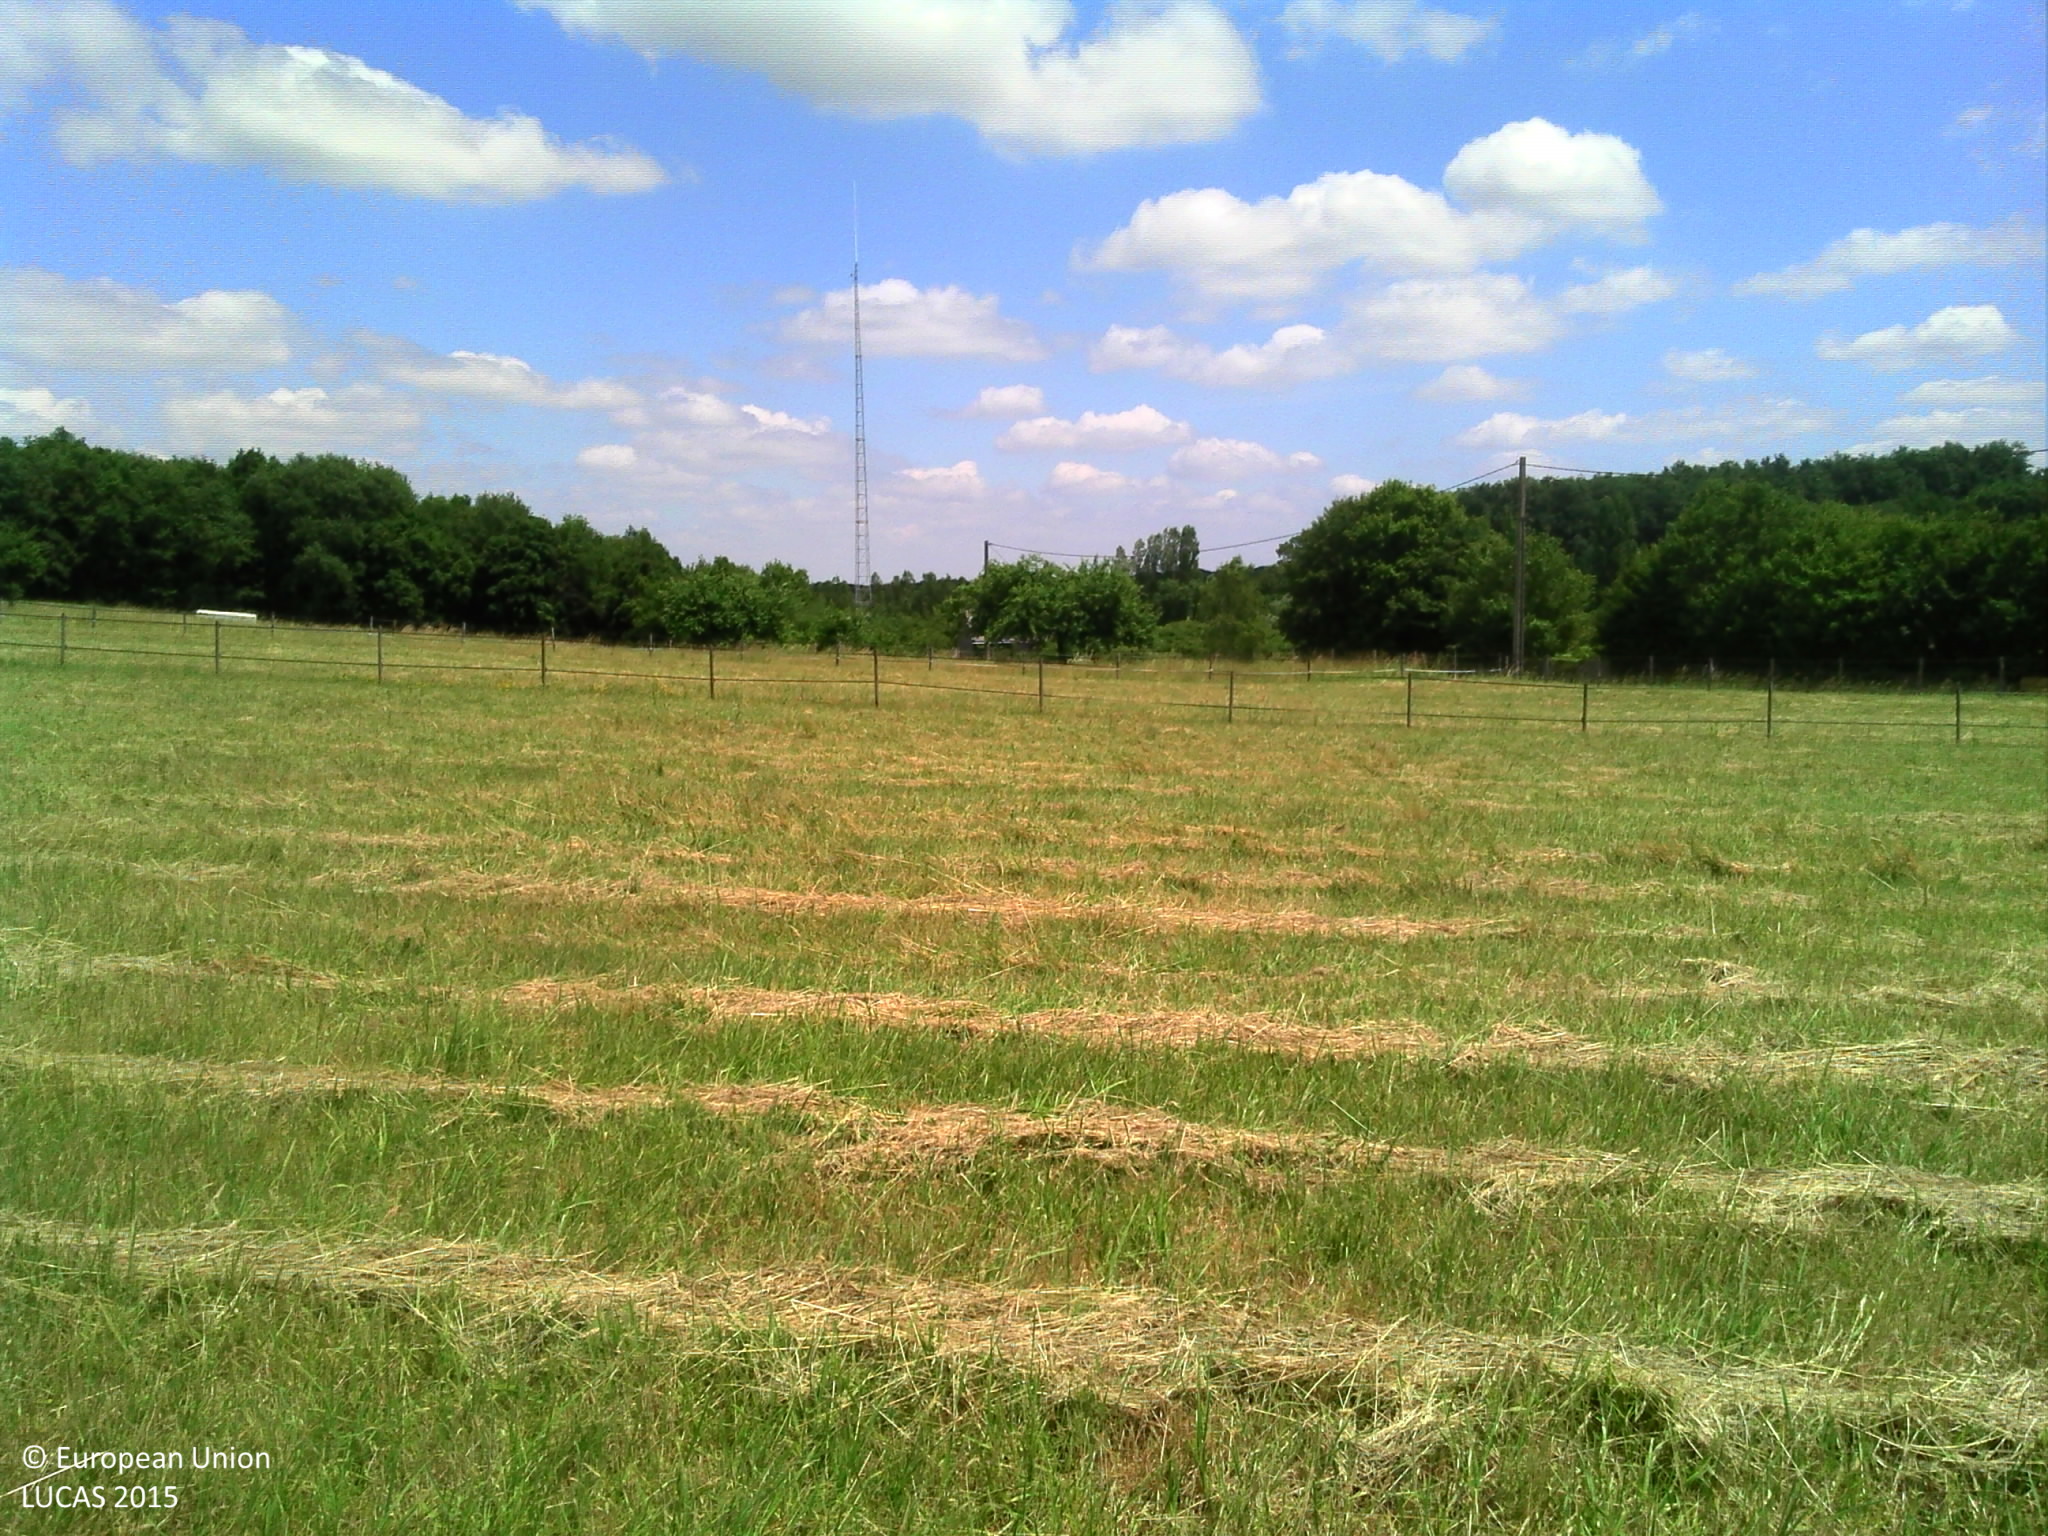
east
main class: Grassland
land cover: Grassland without tree/shrub cover
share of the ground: > 75 %
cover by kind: herbaceous plants 100 %
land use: Agriculture (excluding fallow land and kitchen gardens)
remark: Harvested field
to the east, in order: Grassland without tree/shrub cover; Fences; Grassland without tree/shrub cover; Fences; Electric lines; Grass margins; Ditches and canals; Grass margins; Paved roads, cycling and walking lanes; Lines of trees; Grassland with sparse tree/shrub cover; Shrubland with sparse tree cover; Broadleaved woodland
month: June
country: FR
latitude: 47.4319
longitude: 0.4992
